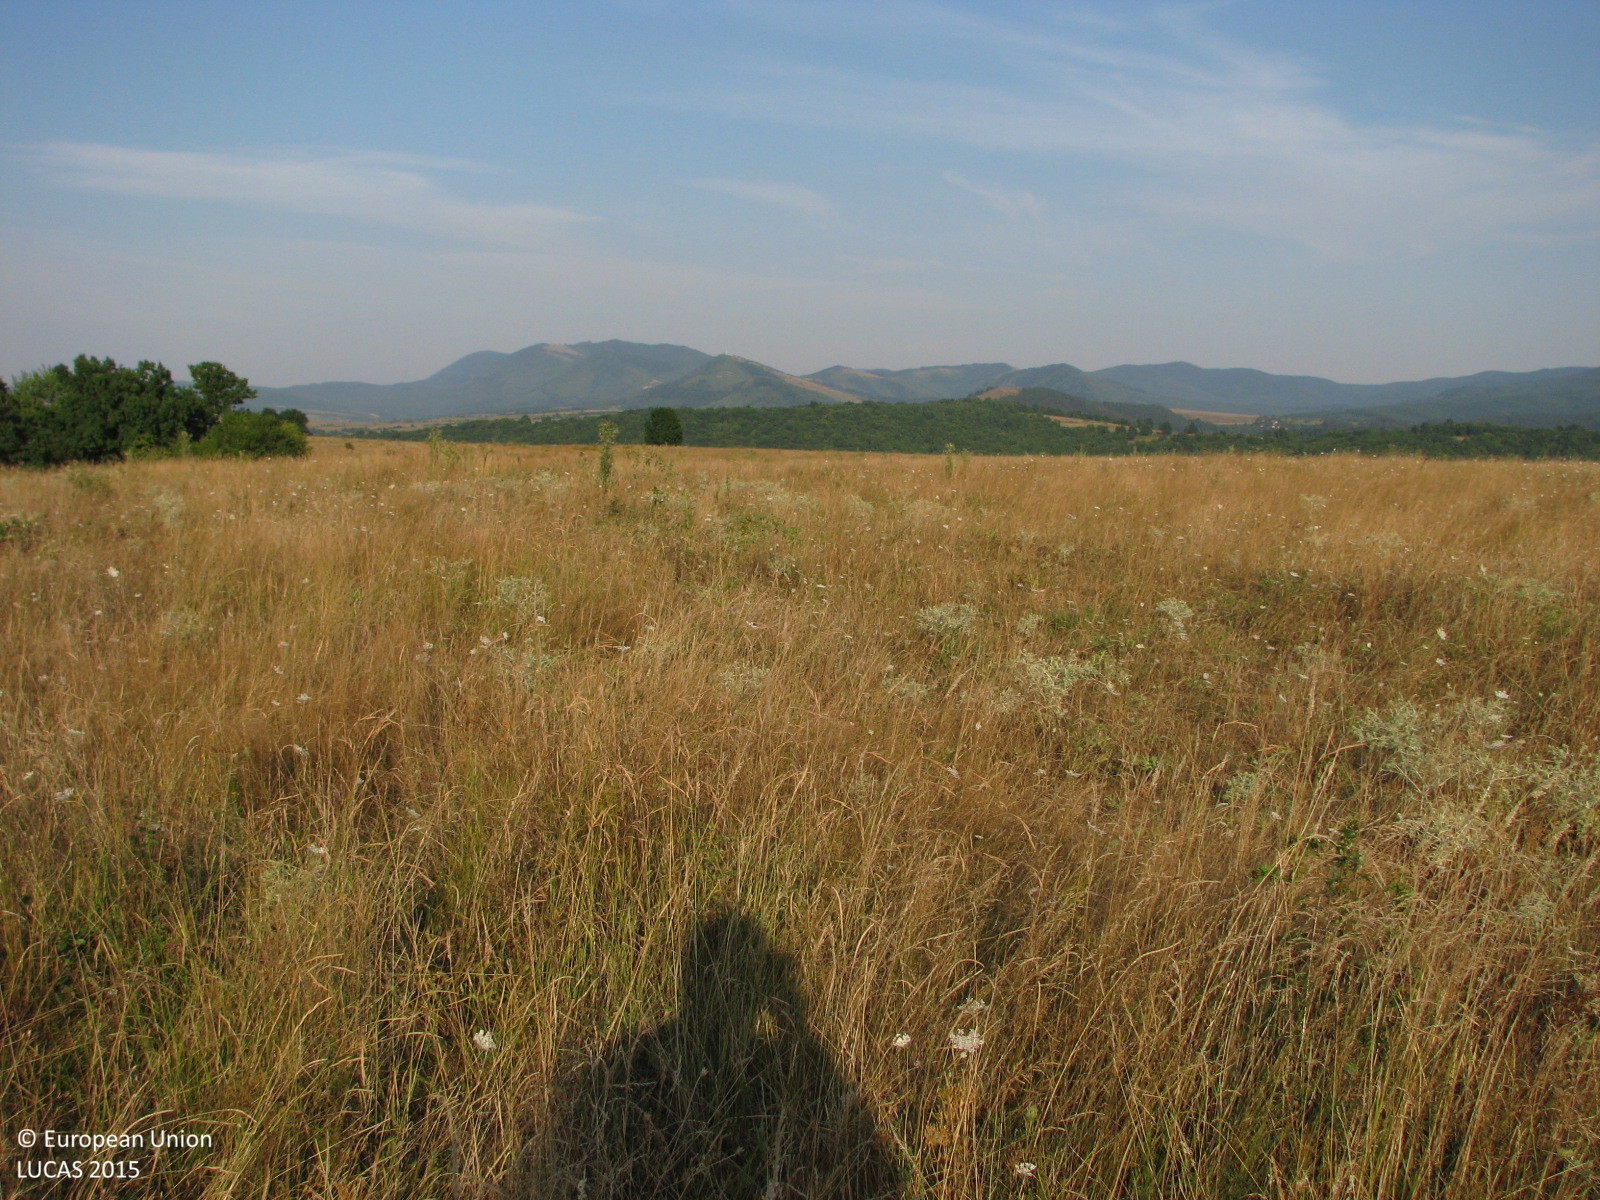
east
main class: Grassland
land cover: Grassland without tree/shrub cover
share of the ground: > 75 %
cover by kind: herbaceous plants 100 %
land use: Agriculture (excluding fallow land and kitchen gardens)
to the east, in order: Grassland without tree/shrub cover
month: August
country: BG
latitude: 42.8929
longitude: 26.1427
